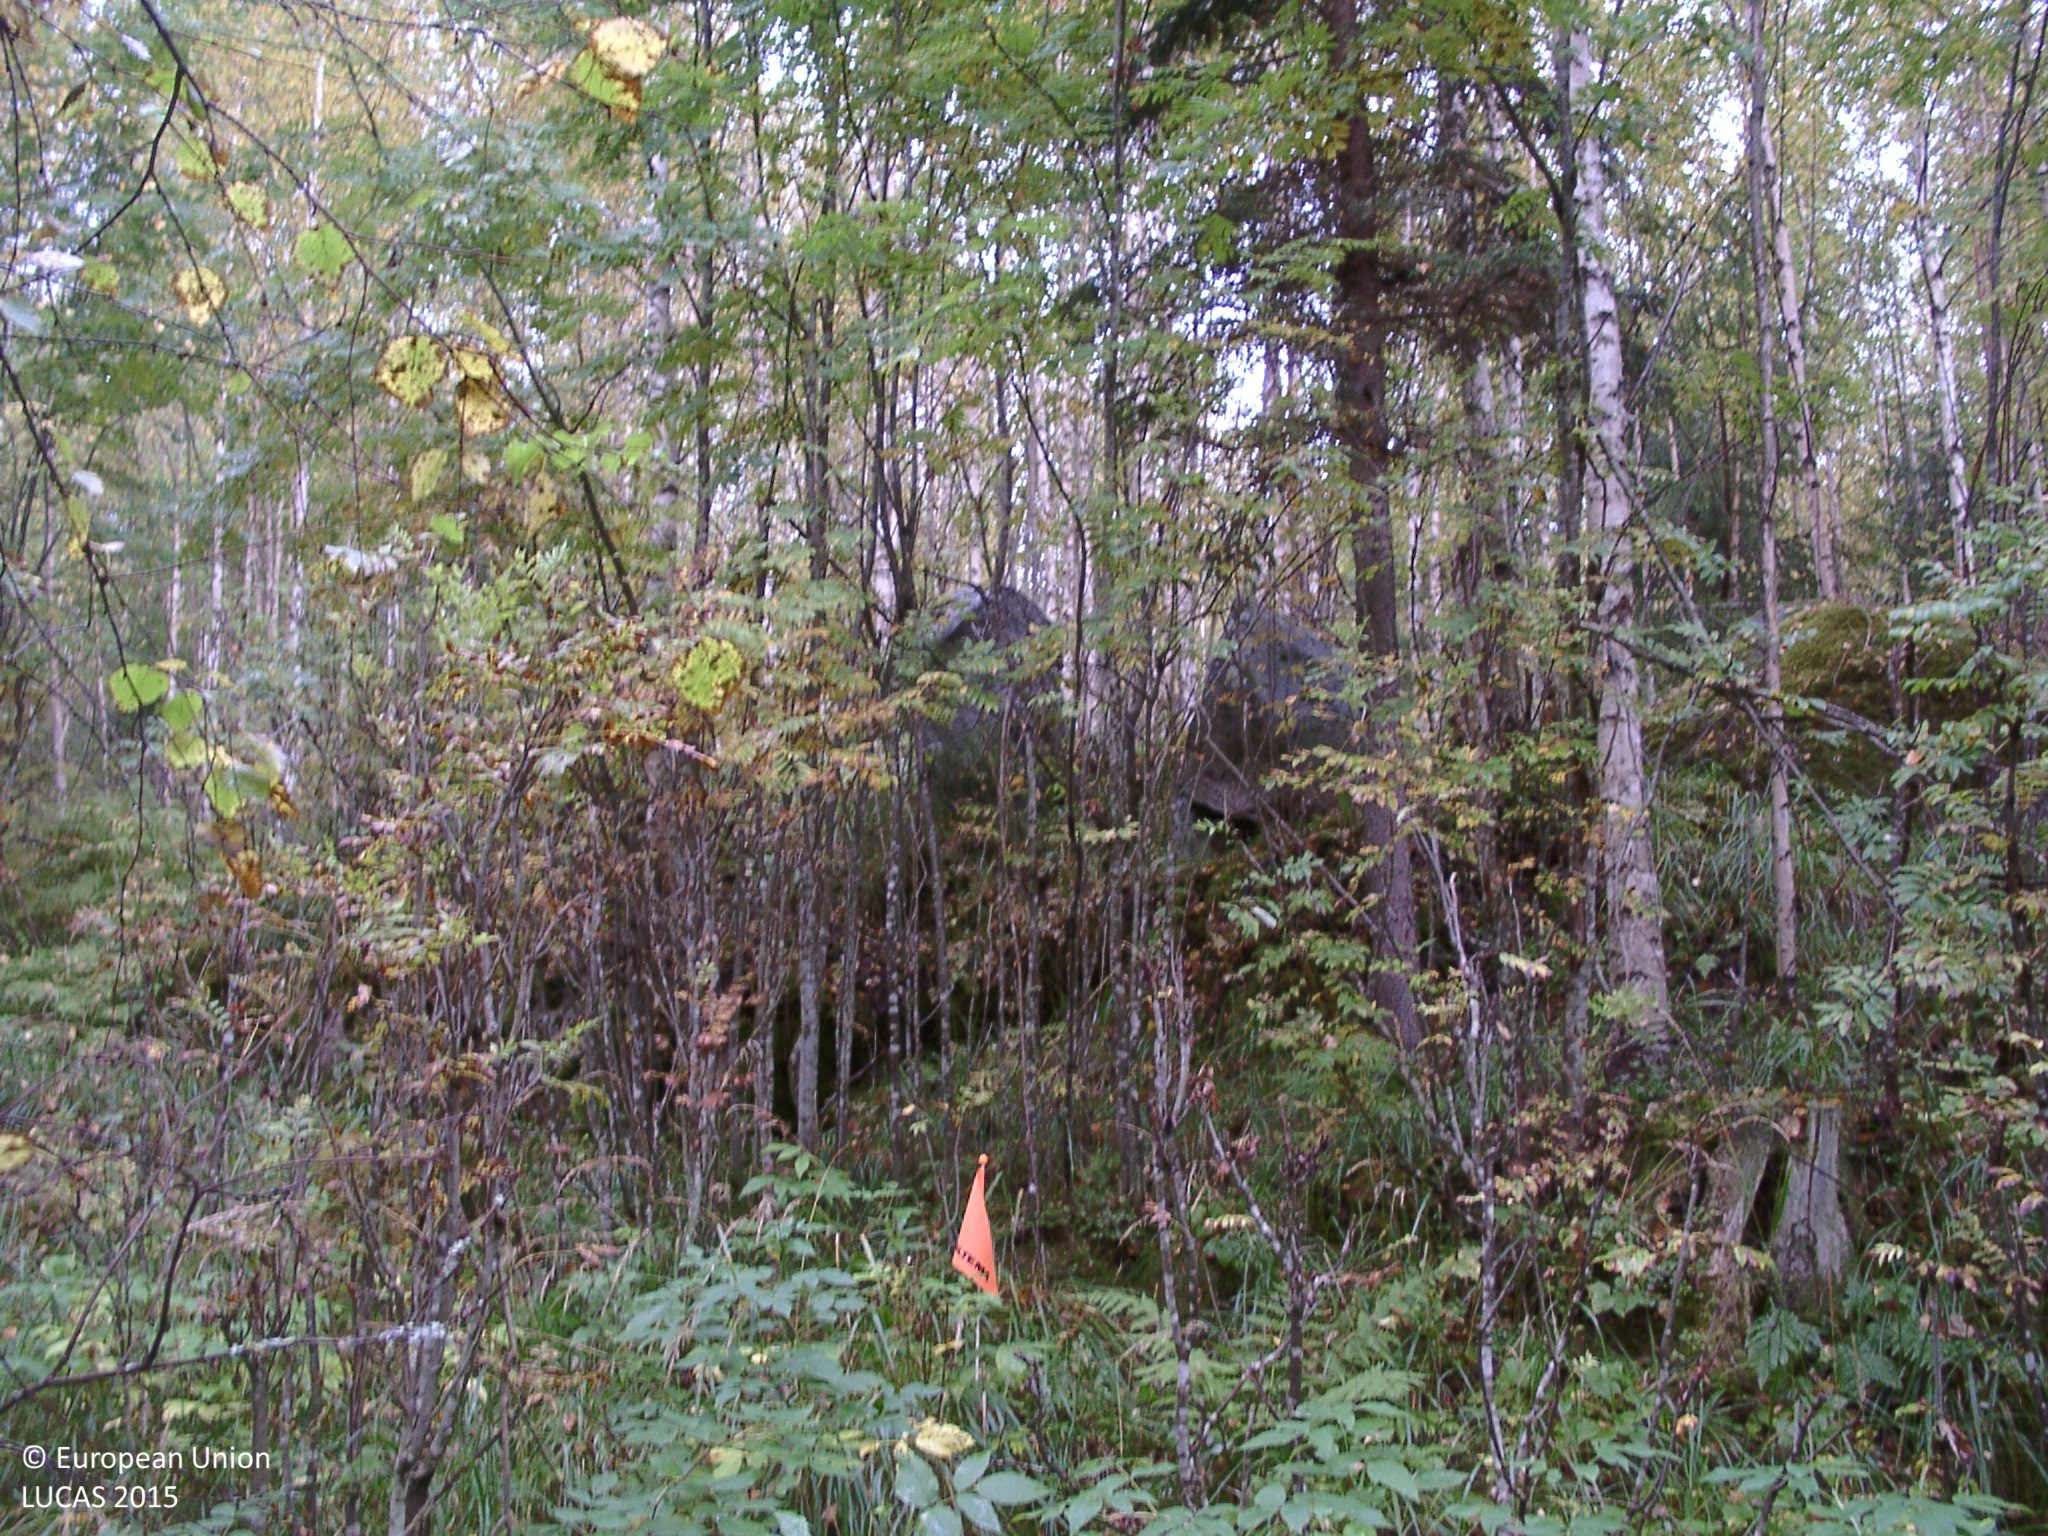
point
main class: Woodland
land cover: Broadleaved woodland
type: boreal forest
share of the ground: 50 - 75 %
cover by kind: broadleaved forest trees 65 %, herbaceous plants 20 %, coniferous forest trees 5 %, shrubs 5 %, lichens and mosses 5 %
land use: Forestry
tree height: > 5 m
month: September
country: FI
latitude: 62.4827
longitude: 25.6959
